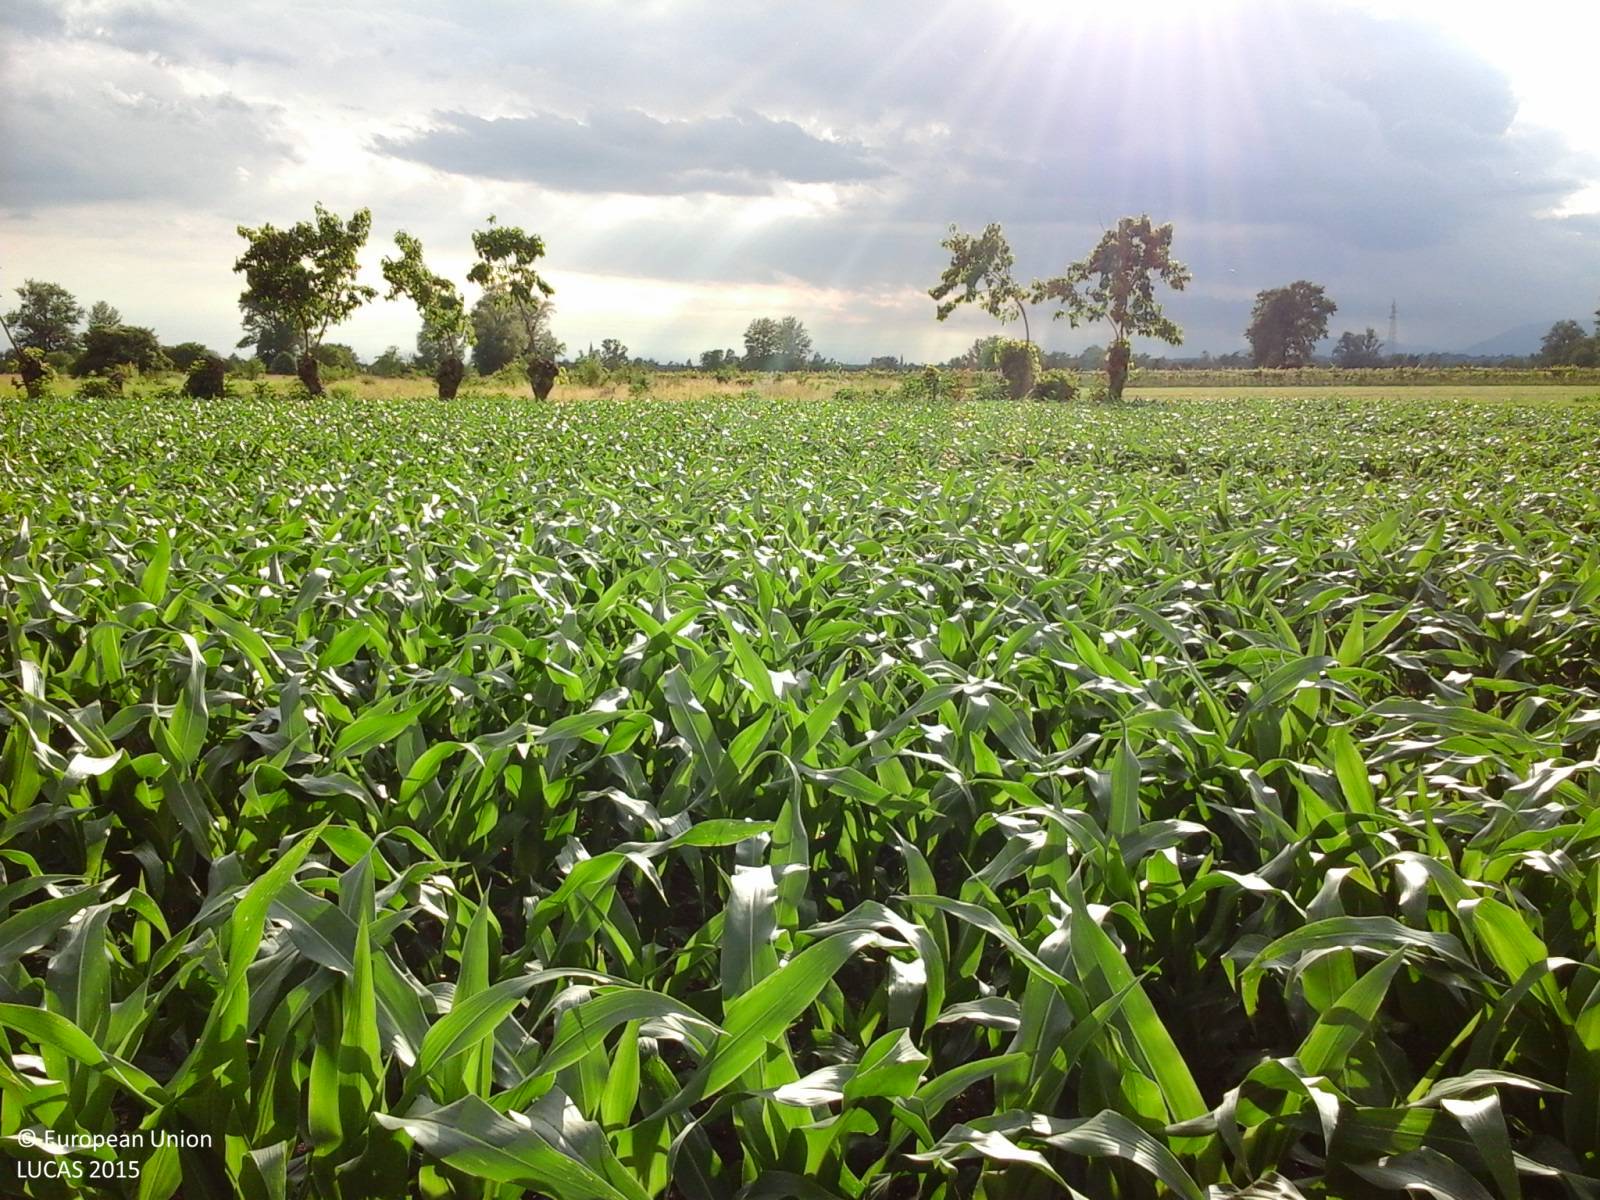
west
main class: Cropland
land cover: Maize
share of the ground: > 75 %
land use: Agriculture (excluding fallow land and kitchen gardens)
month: May
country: IT
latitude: 46.1390
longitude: 13.2716
